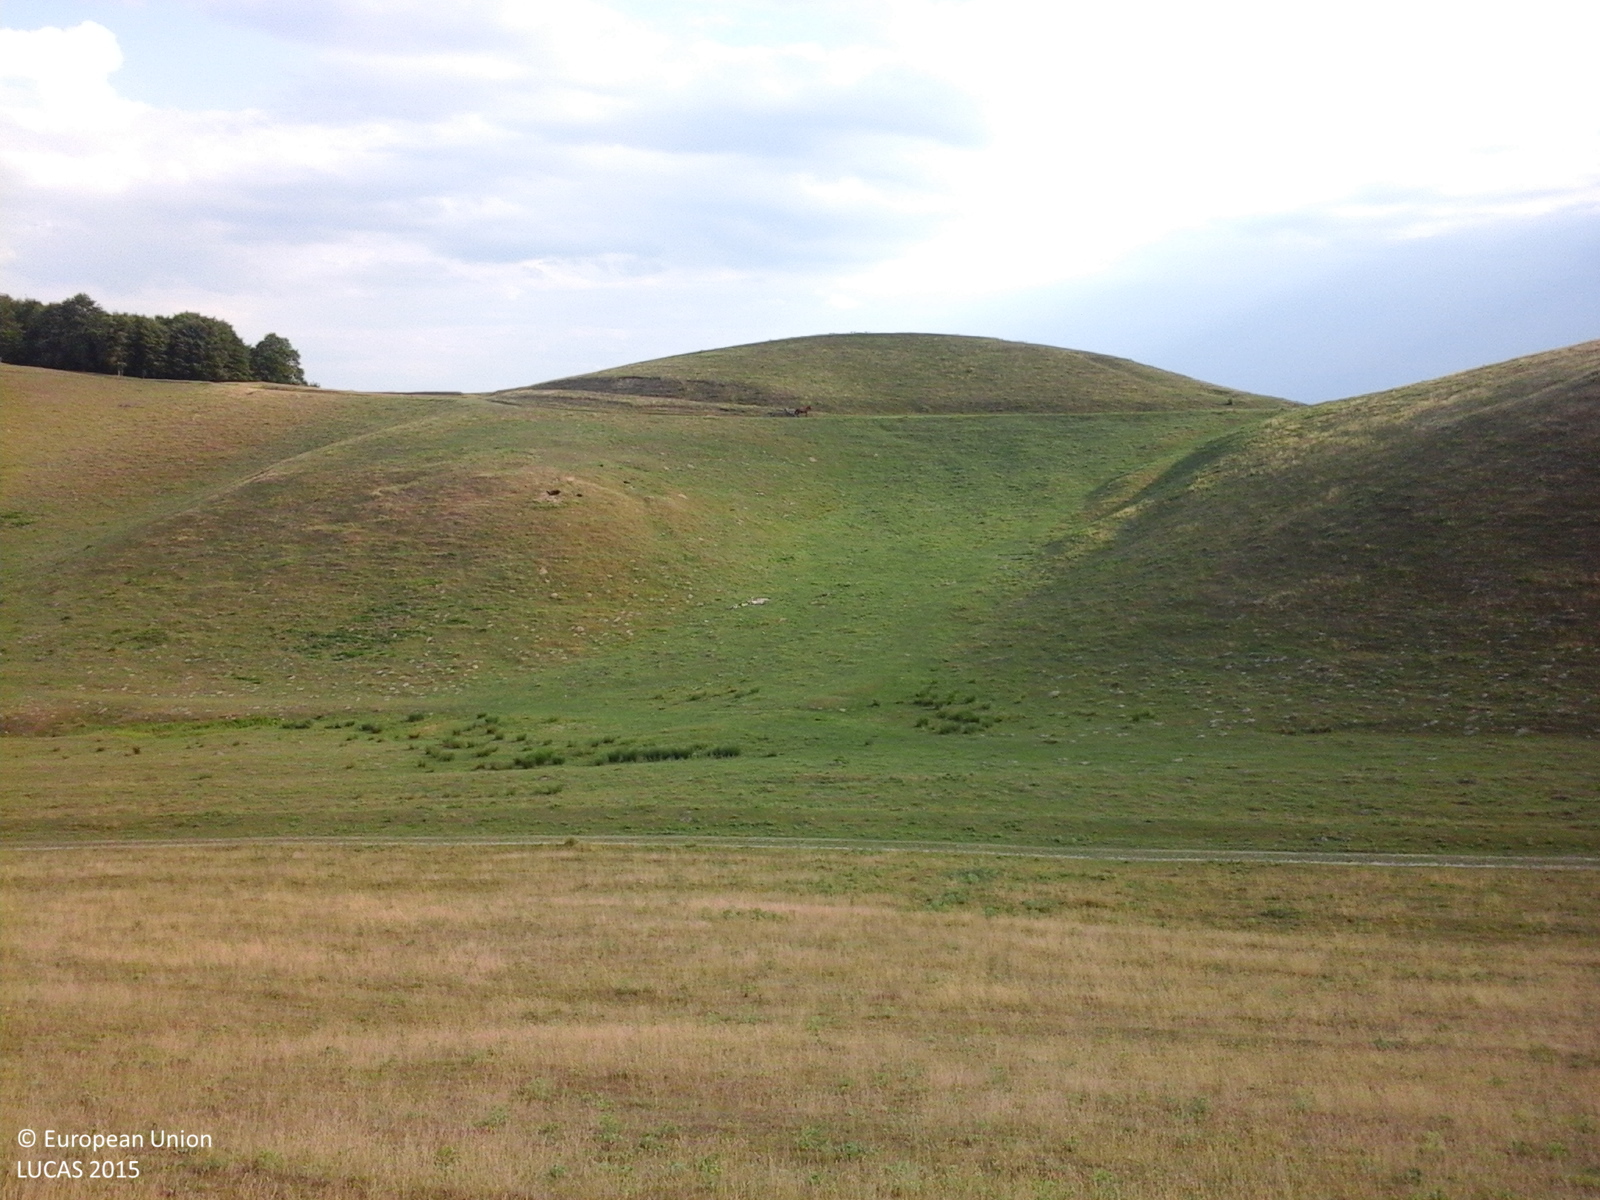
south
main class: Grassland
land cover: Grassland without tree/shrub cover
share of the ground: > 75 %
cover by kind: herbaceous plants 100 %
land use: Agriculture (excluding fallow land and kitchen gardens)
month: June
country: RO
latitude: 47.5506
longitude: 26.4179
